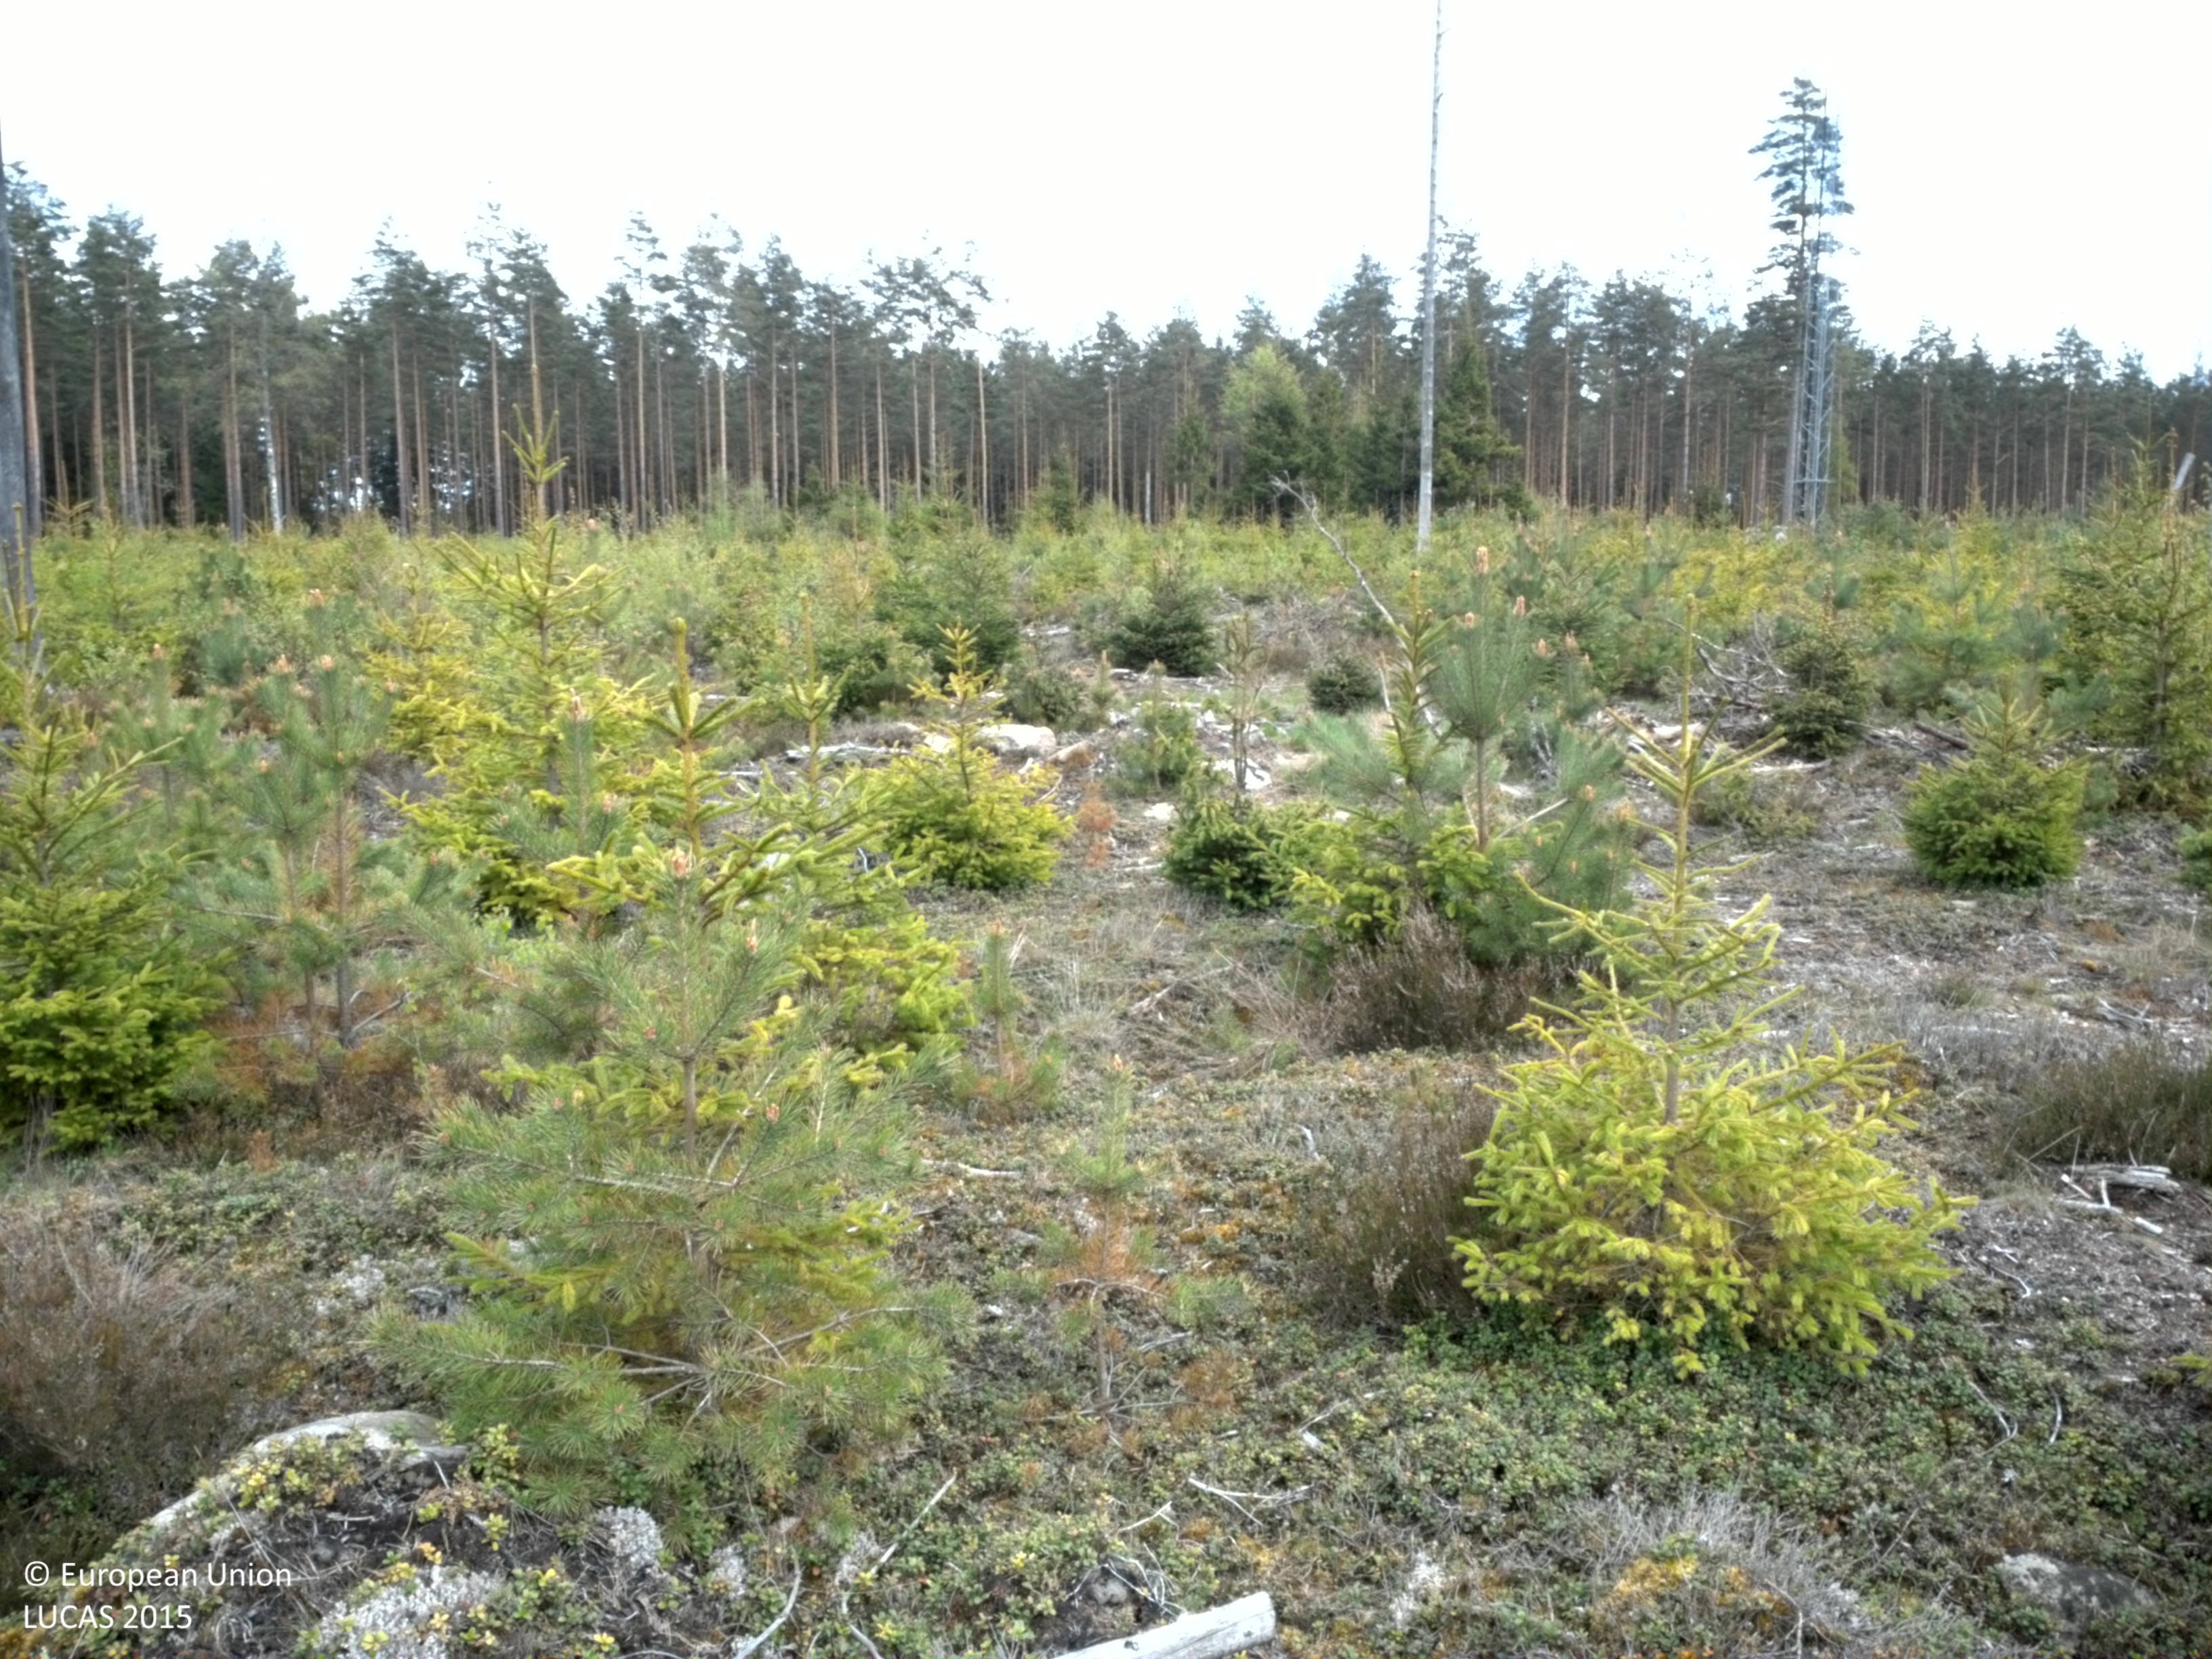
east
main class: Woodland
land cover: Other coniferous woodland
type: boreal forest
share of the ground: > 75 %
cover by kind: coniferous forest trees 90 %, shrubs 5 %, lichens and mosses 5 %
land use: Forestry
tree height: < 5 m
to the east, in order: Other coniferous woodland; Paved roads, cycling and walking lanes; Grass margins; Pine dominated coniferous woodland; Spruce dominated coniferous woodland; Grass margins; Paved roads, cycling and walking lanes; Grass margins; Spruce dominated coniferous woodland
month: May
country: SE
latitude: 56.7764
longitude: 15.4150
